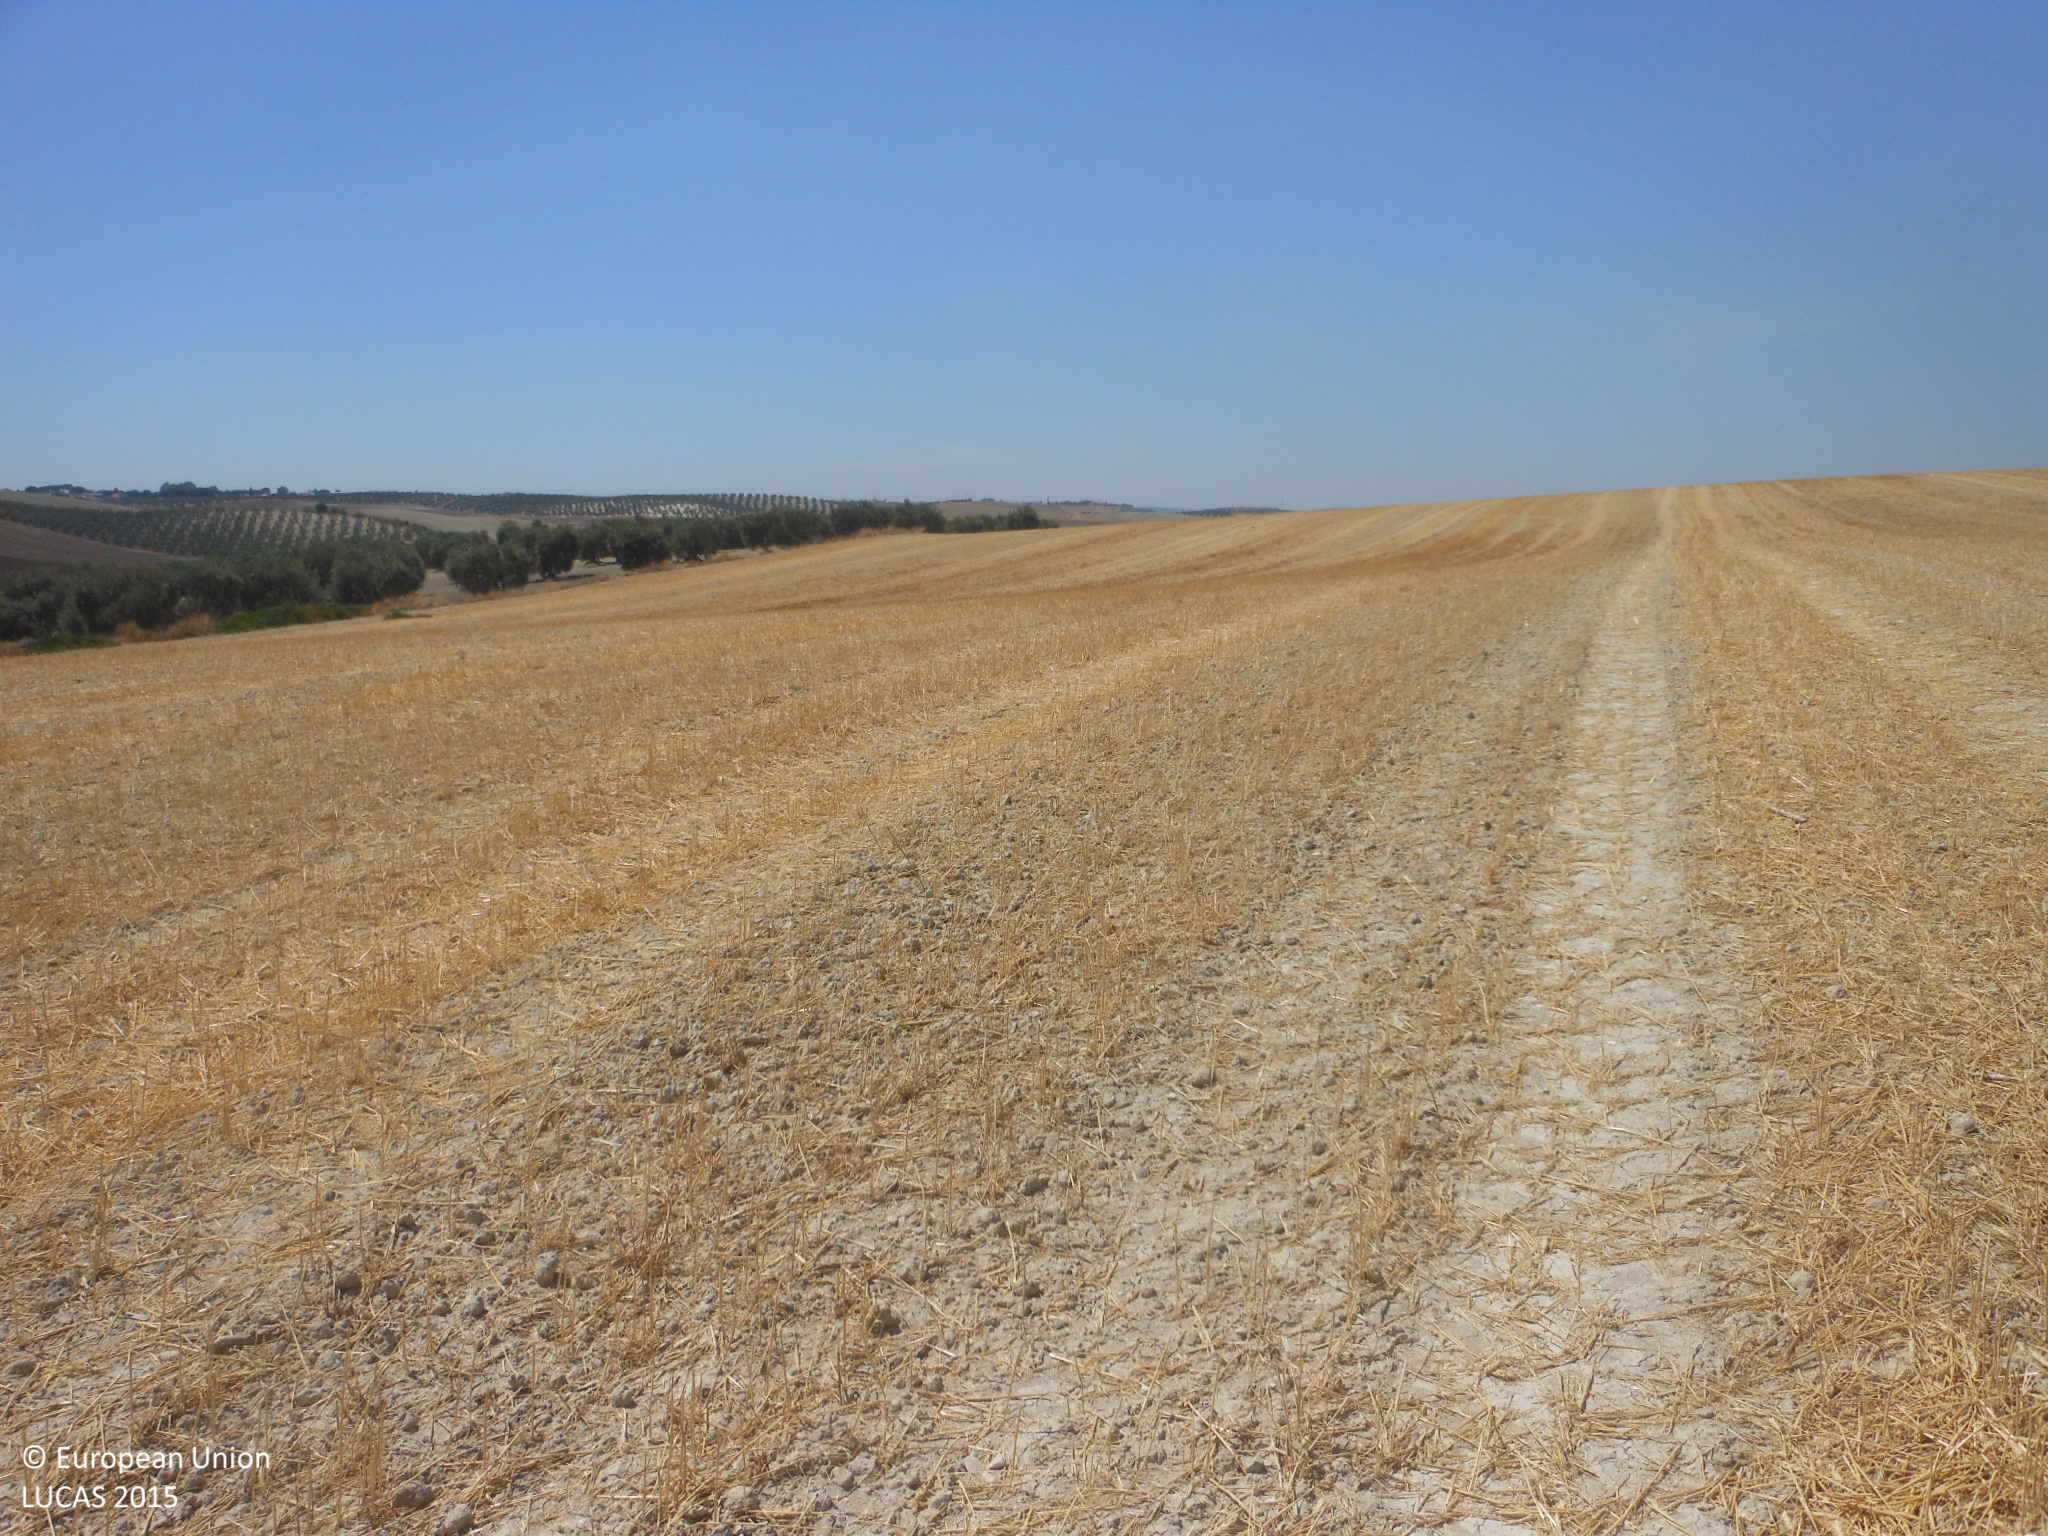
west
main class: Cropland
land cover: Common wheat
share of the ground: < 10 %
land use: Agriculture (excluding fallow land and kitchen gardens)
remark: Harvested field
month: July
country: ES
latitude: 37.3008
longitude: -5.3667
